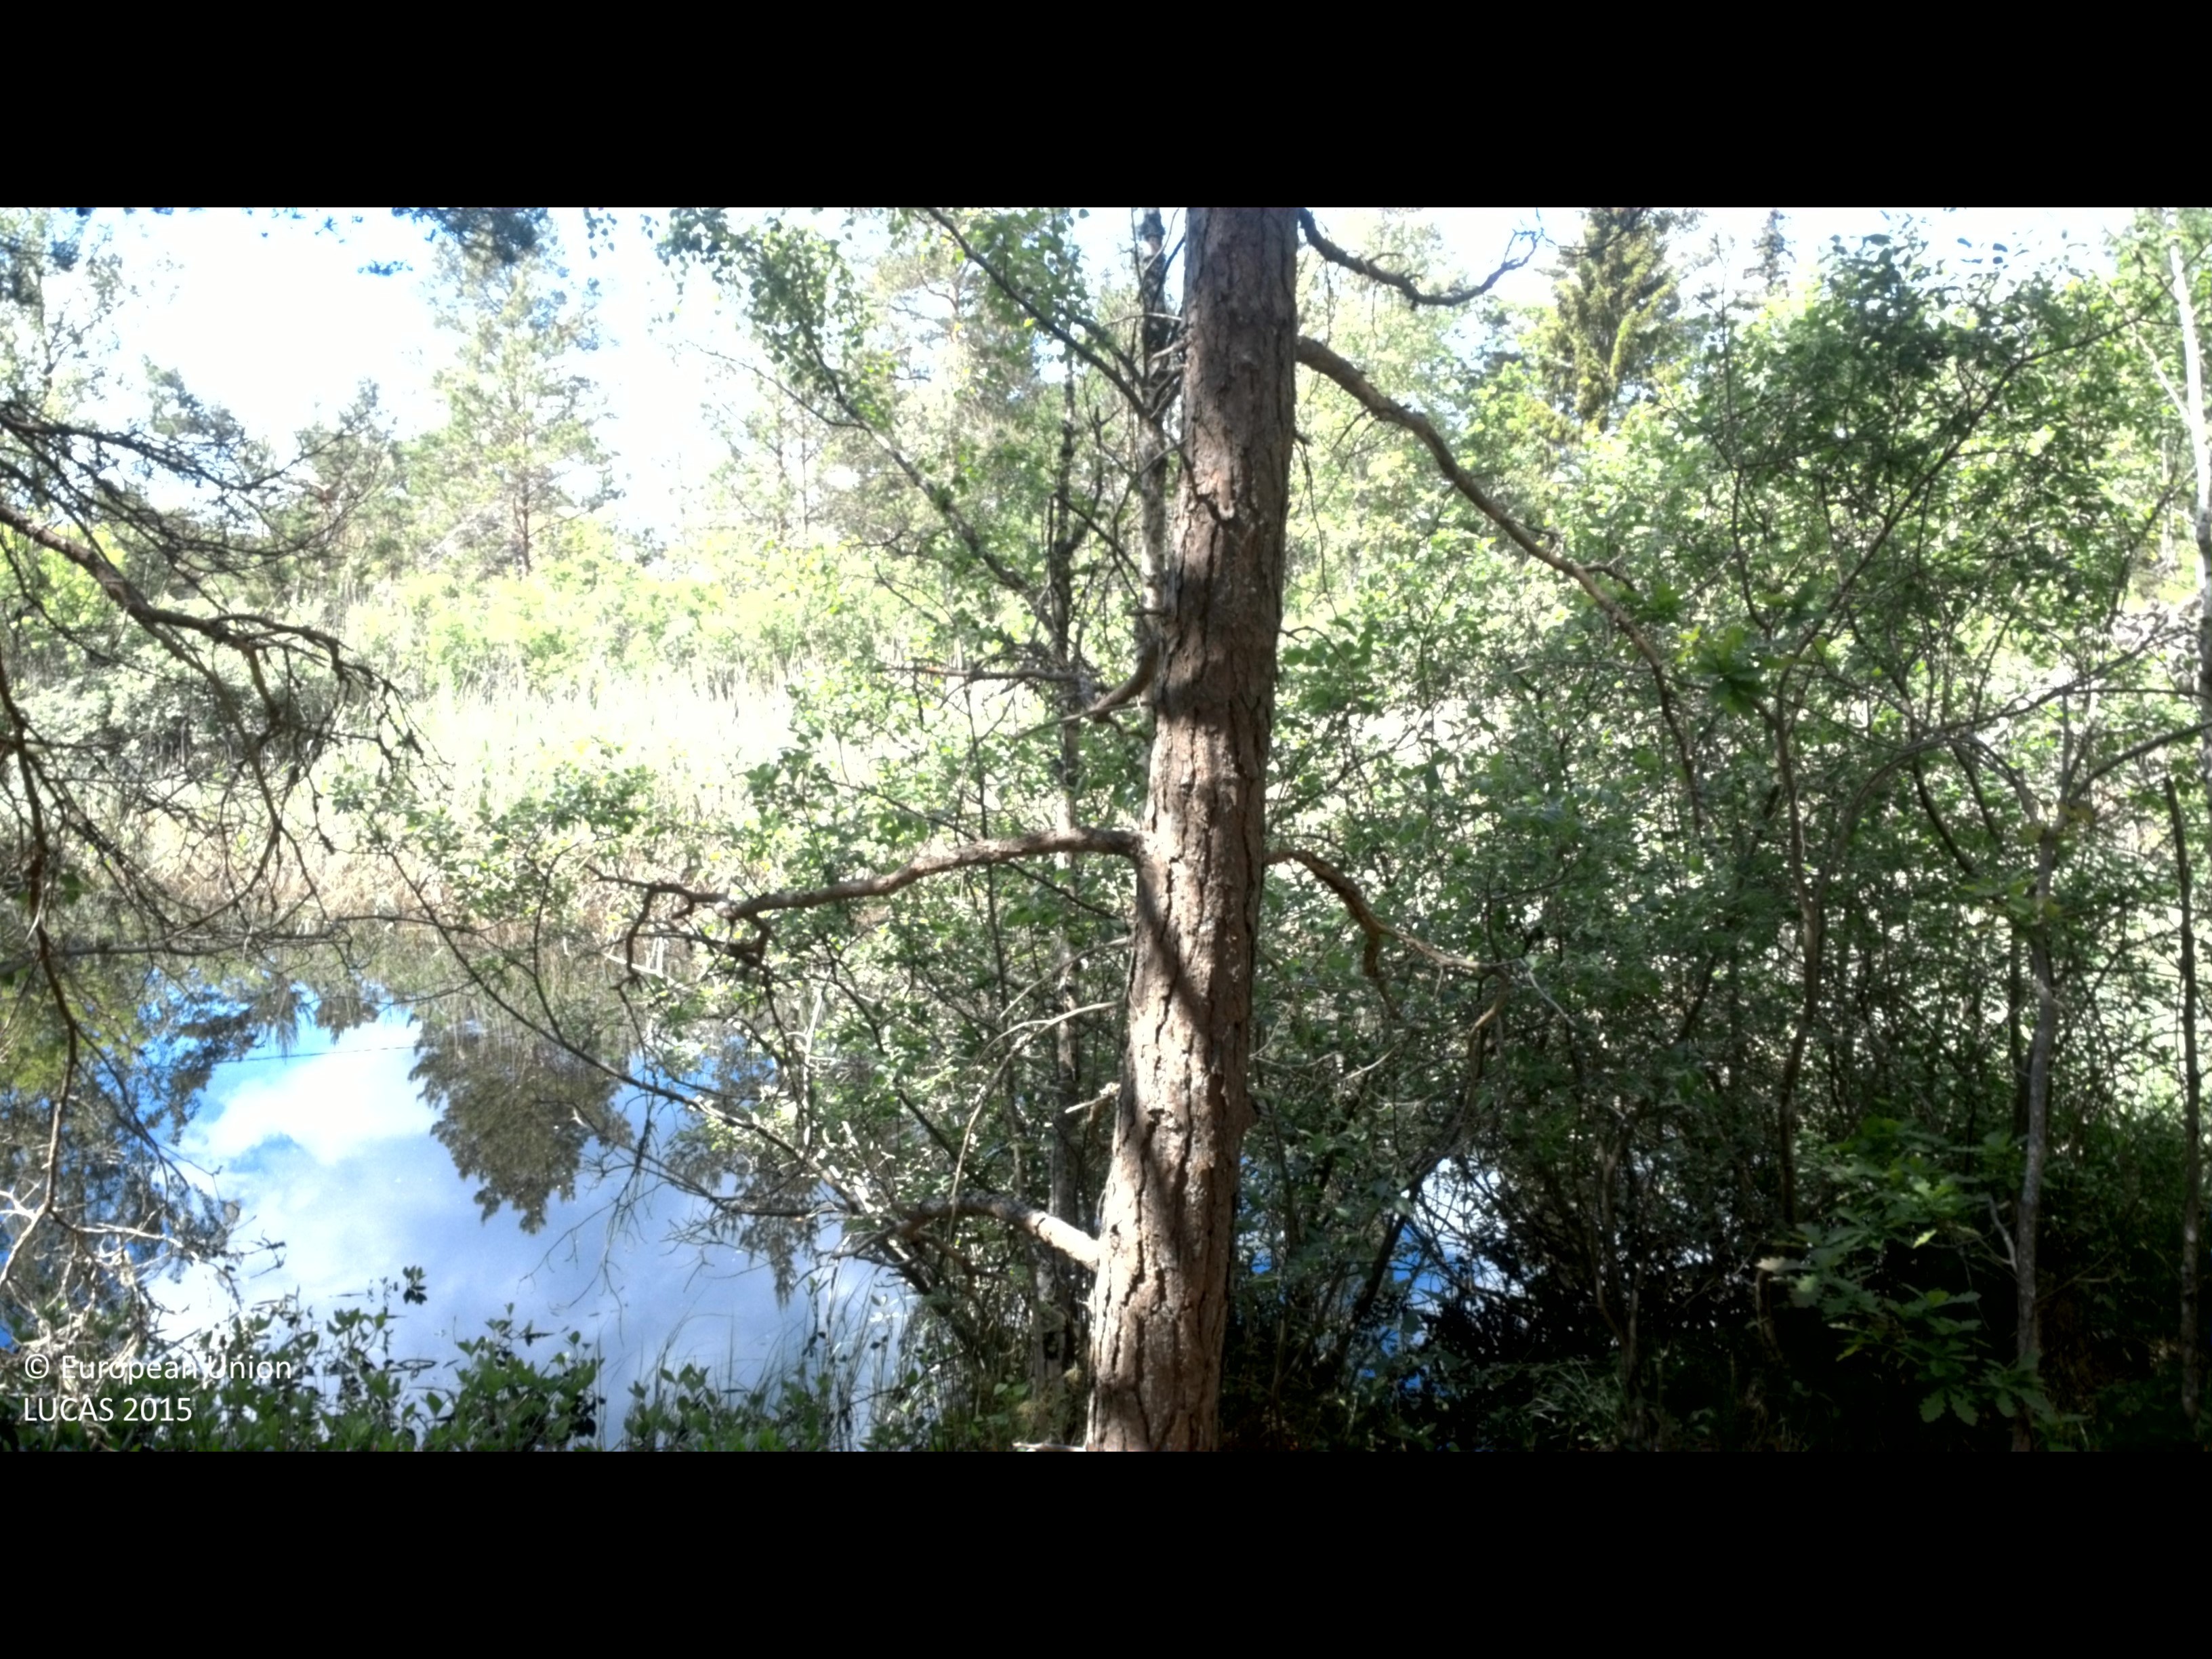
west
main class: Woodland
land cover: Pine dominated coniferous woodland
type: hemiboreal forest and nemoral coniferous forest and mixed broadleaved-coniferous forest
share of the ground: 50 - 75 %
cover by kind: coniferous forest trees 55 %, broadleaved forest trees 15 %, consolidated bare surface 15 %, lichens and mosses 10 %, shrubs 5 %
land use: Forestry
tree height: > 5 m
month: June
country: SE
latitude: 57.6950
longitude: 16.6258
